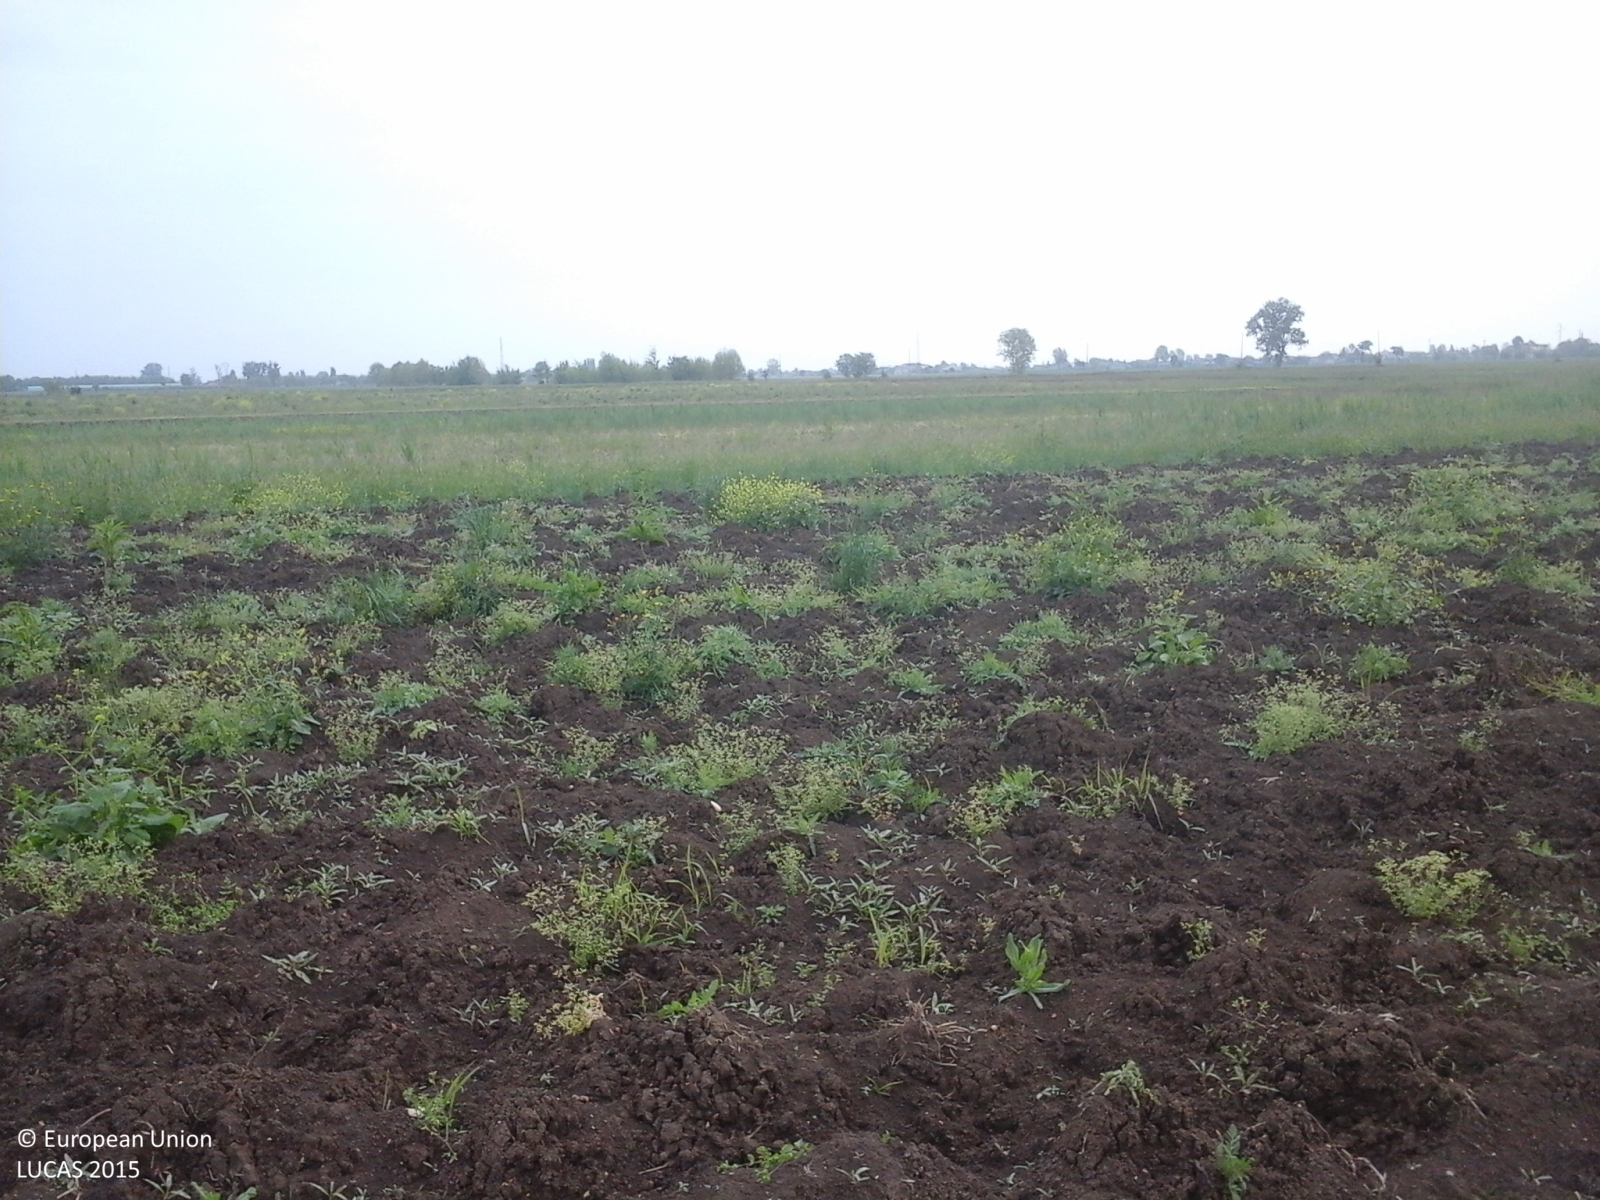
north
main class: Grassland
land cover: Spontaneously vegetated surfaces
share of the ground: 25 - 50 %
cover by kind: consolidated bare surface 80 %, herbaceous plants 20 %
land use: Fallow land
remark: Tilled/Sowed
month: May
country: IT
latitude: 45.3658
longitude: 11.6187
